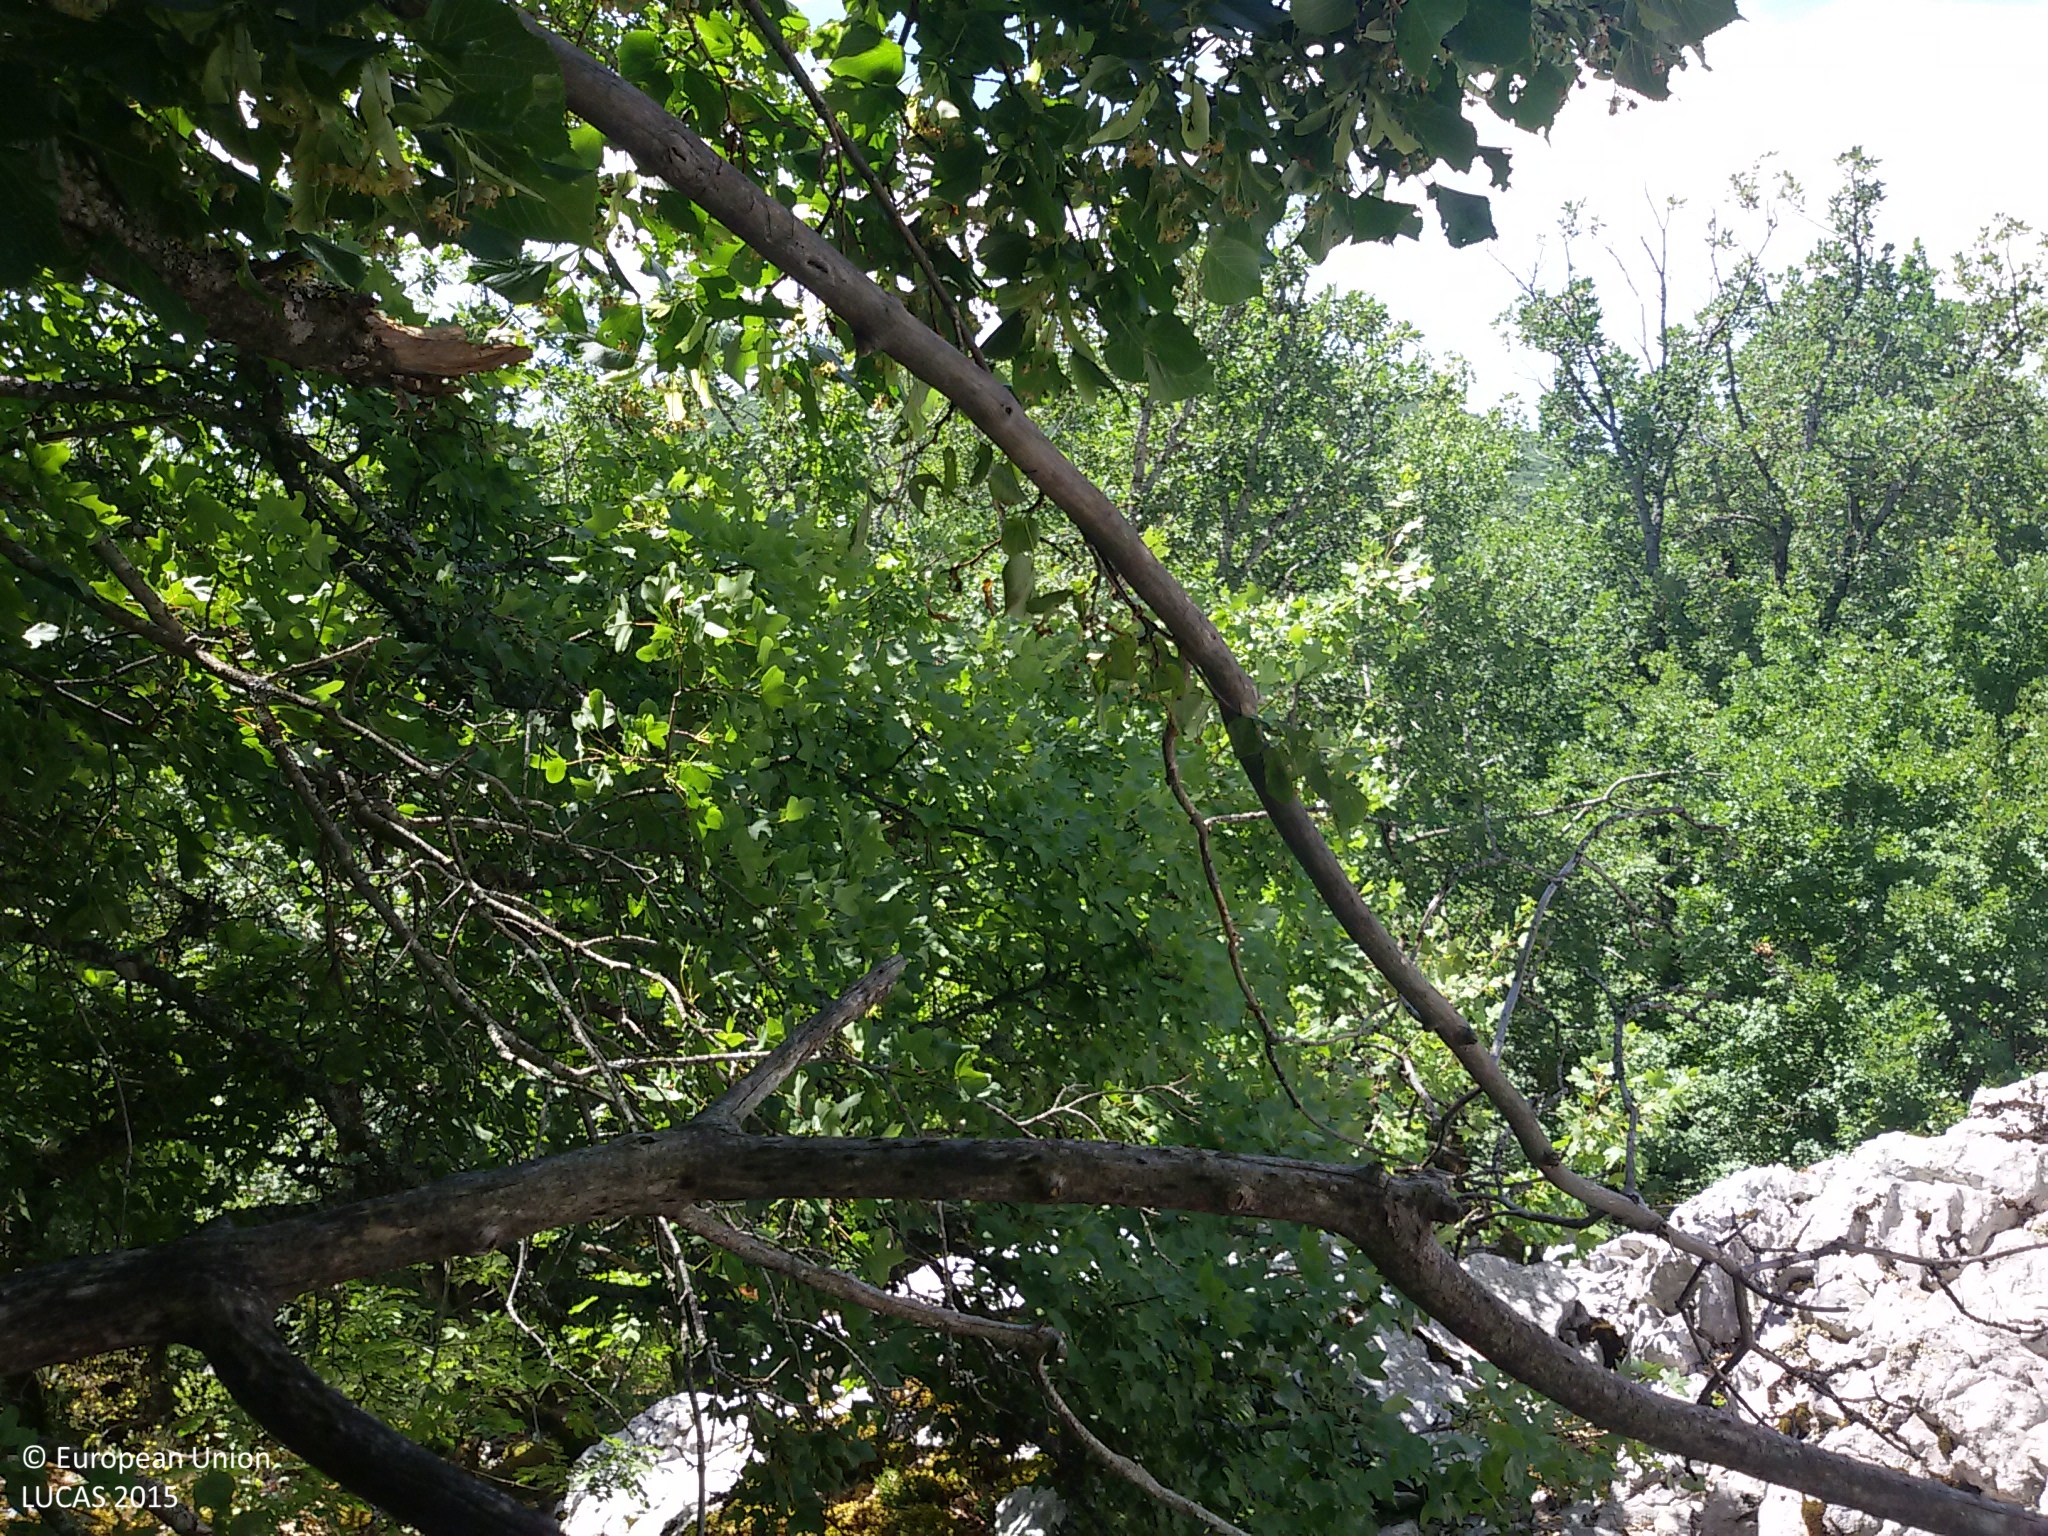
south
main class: Woodland
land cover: Broadleaved woodland
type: mountainous beech forest
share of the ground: 50 - 75 %
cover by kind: broadleaved forest trees 50 %, consolidated bare surface 20 %, shrubs 10 %, lichens and mosses 10 %, herbaceous plants 5 %, unconsolidated bare surface 5 %
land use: Semi-natural and natural areas not in use
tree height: > 5 m
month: June
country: HR
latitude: 44.5610
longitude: 15.5962
